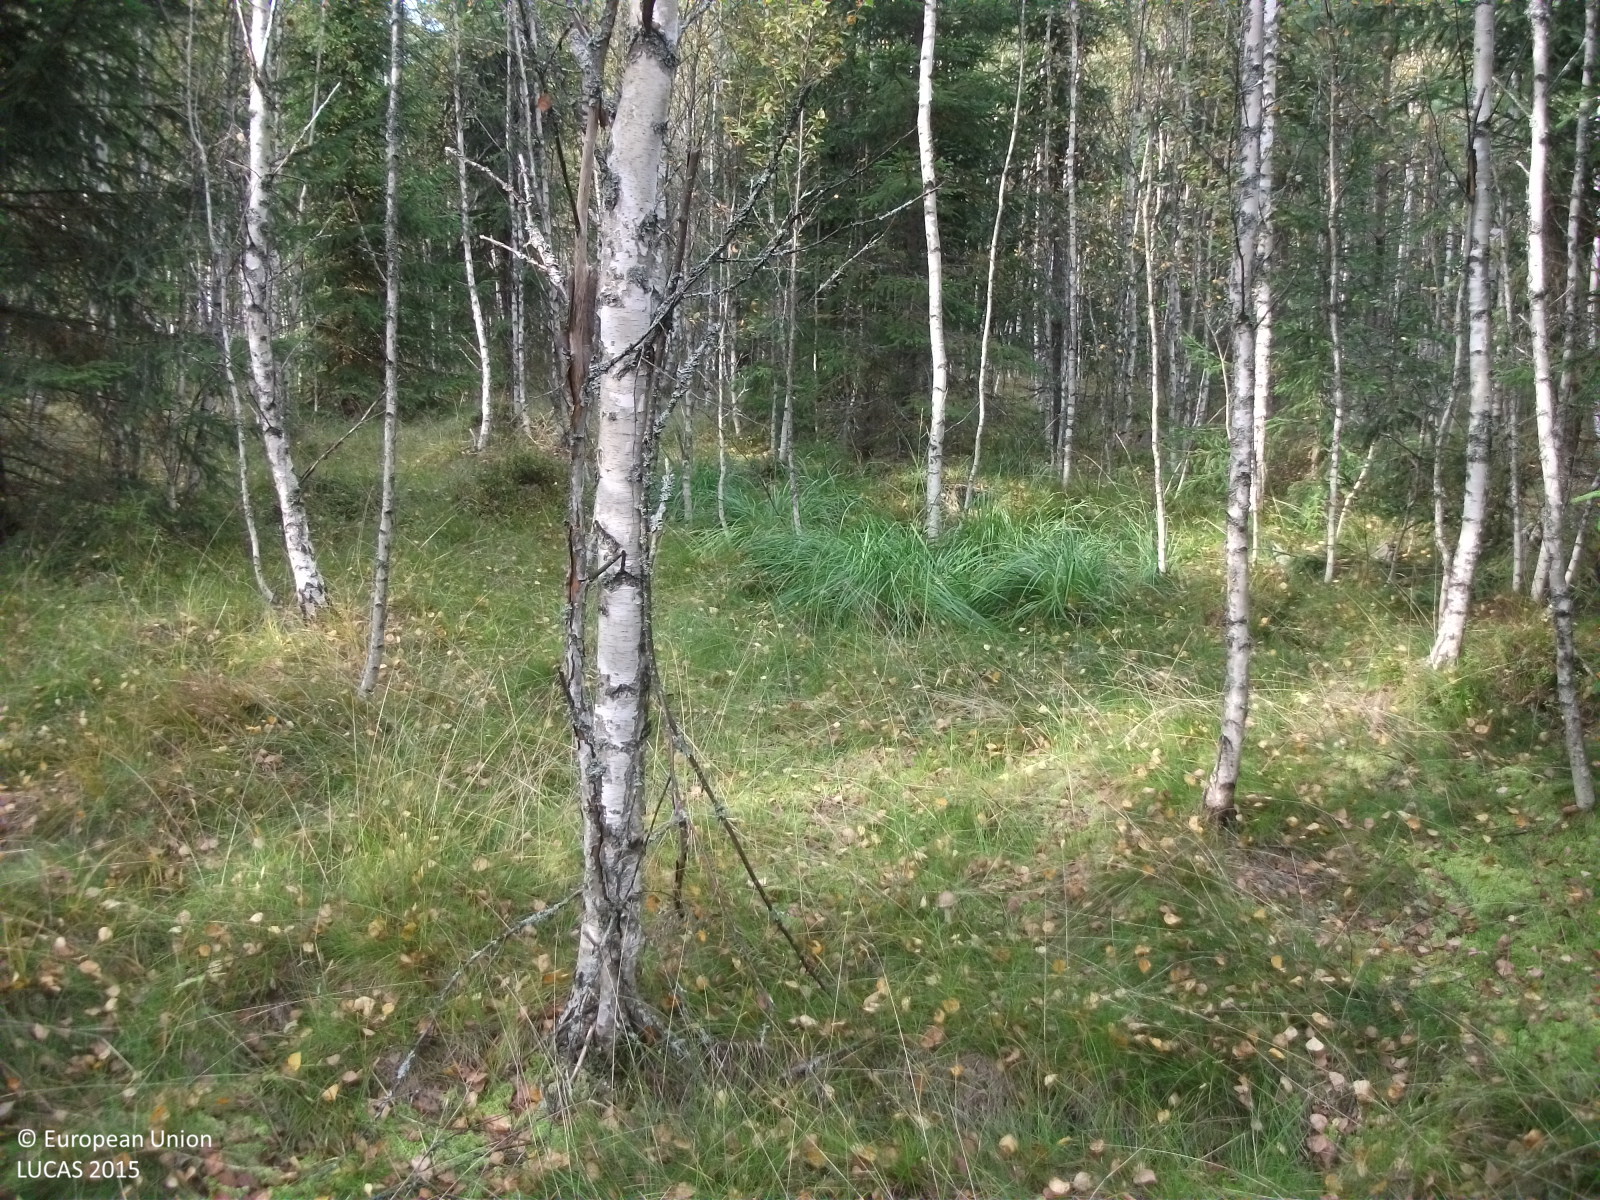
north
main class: Woodland
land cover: Spruce dominated mixed woodland
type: hemiboreal forest and nemoral coniferous forest and mixed broadleaved-coniferous forest
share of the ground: > 75 %
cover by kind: broadleaved forest trees 55 %, coniferous forest trees 30 %, herbaceous plants 15 %
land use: Forestry
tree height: > 5 m
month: September
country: LV
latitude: 57.8125
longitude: 24.8241
